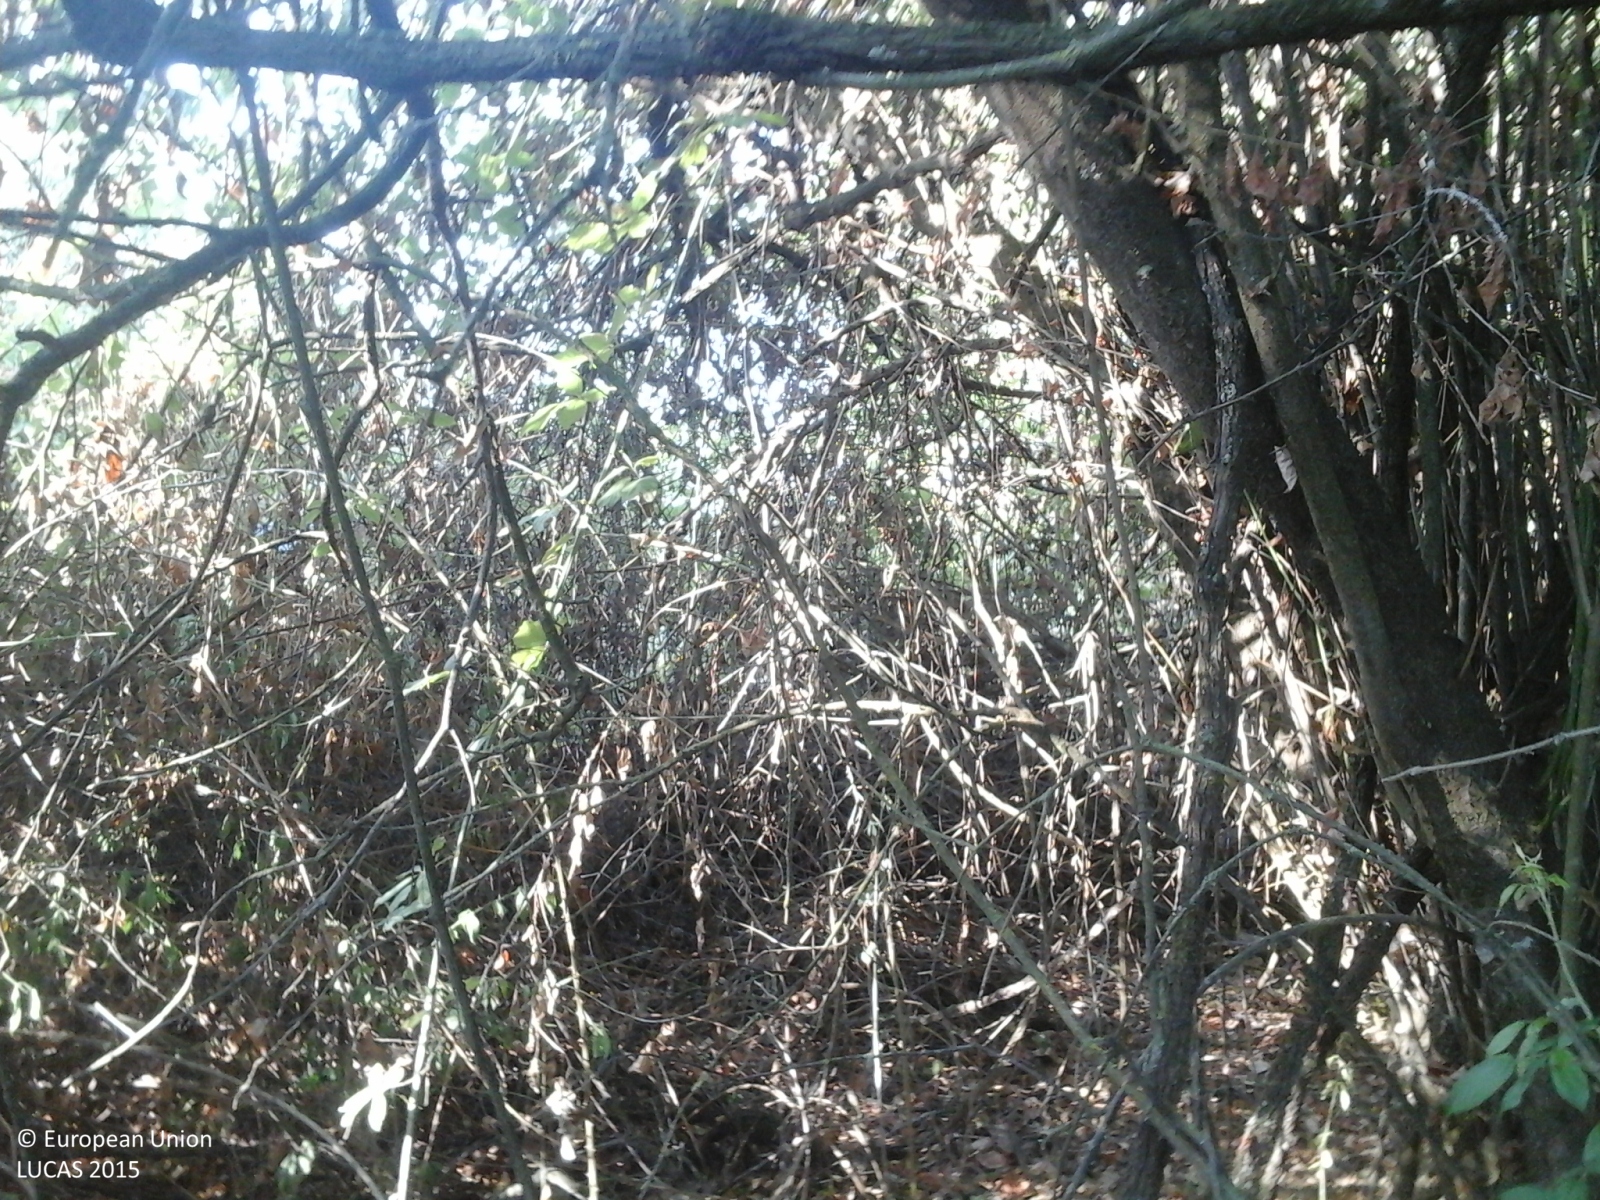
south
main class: Woodland
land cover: Broadleaved woodland
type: thermophilous deciduous forest
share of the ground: > 75 %
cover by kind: broadleaved forest trees 90 %, shrubs 10 %
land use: Abandoned areas
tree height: > 5 m
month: August
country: IT
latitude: 43.8073
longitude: 10.6571
